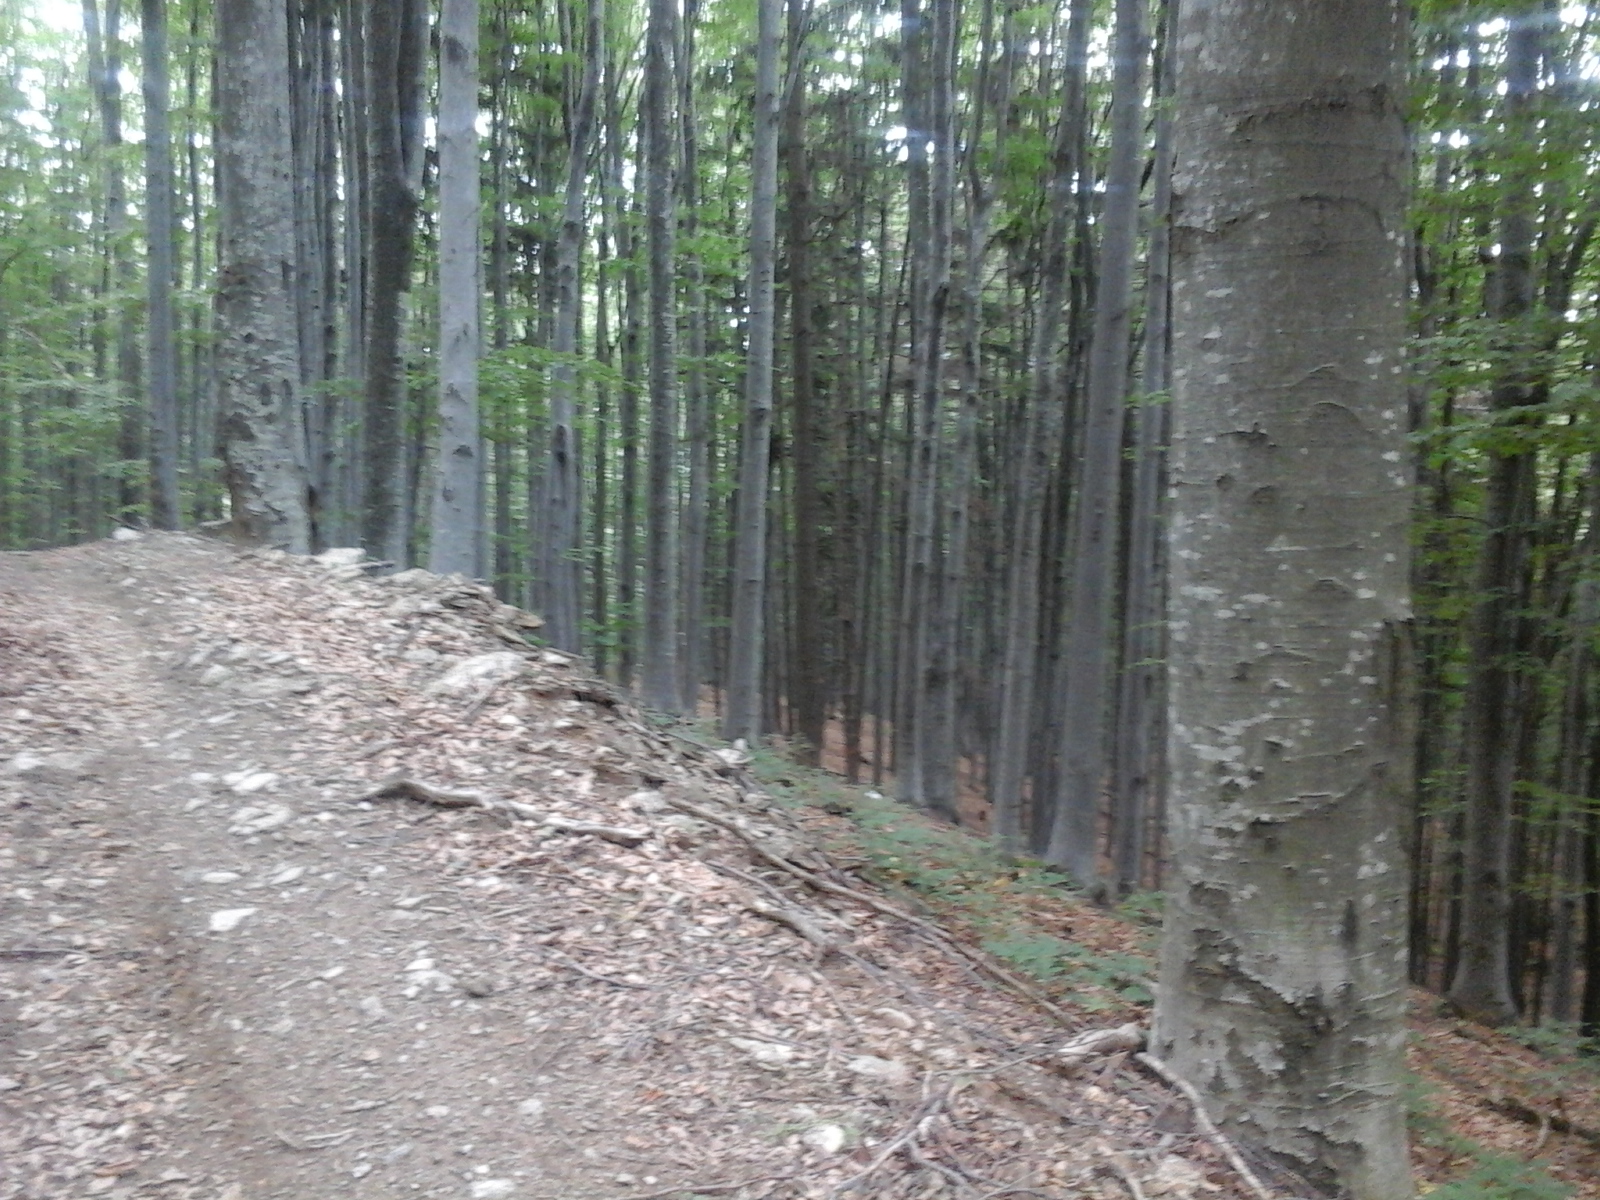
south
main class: Woodland
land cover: Broadleaved woodland
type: beech forest
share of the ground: > 75 %
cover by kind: broadleaved forest trees 100 %
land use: Forestry
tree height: > 5 m
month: August
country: RO
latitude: 45.2275
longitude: 22.0736
